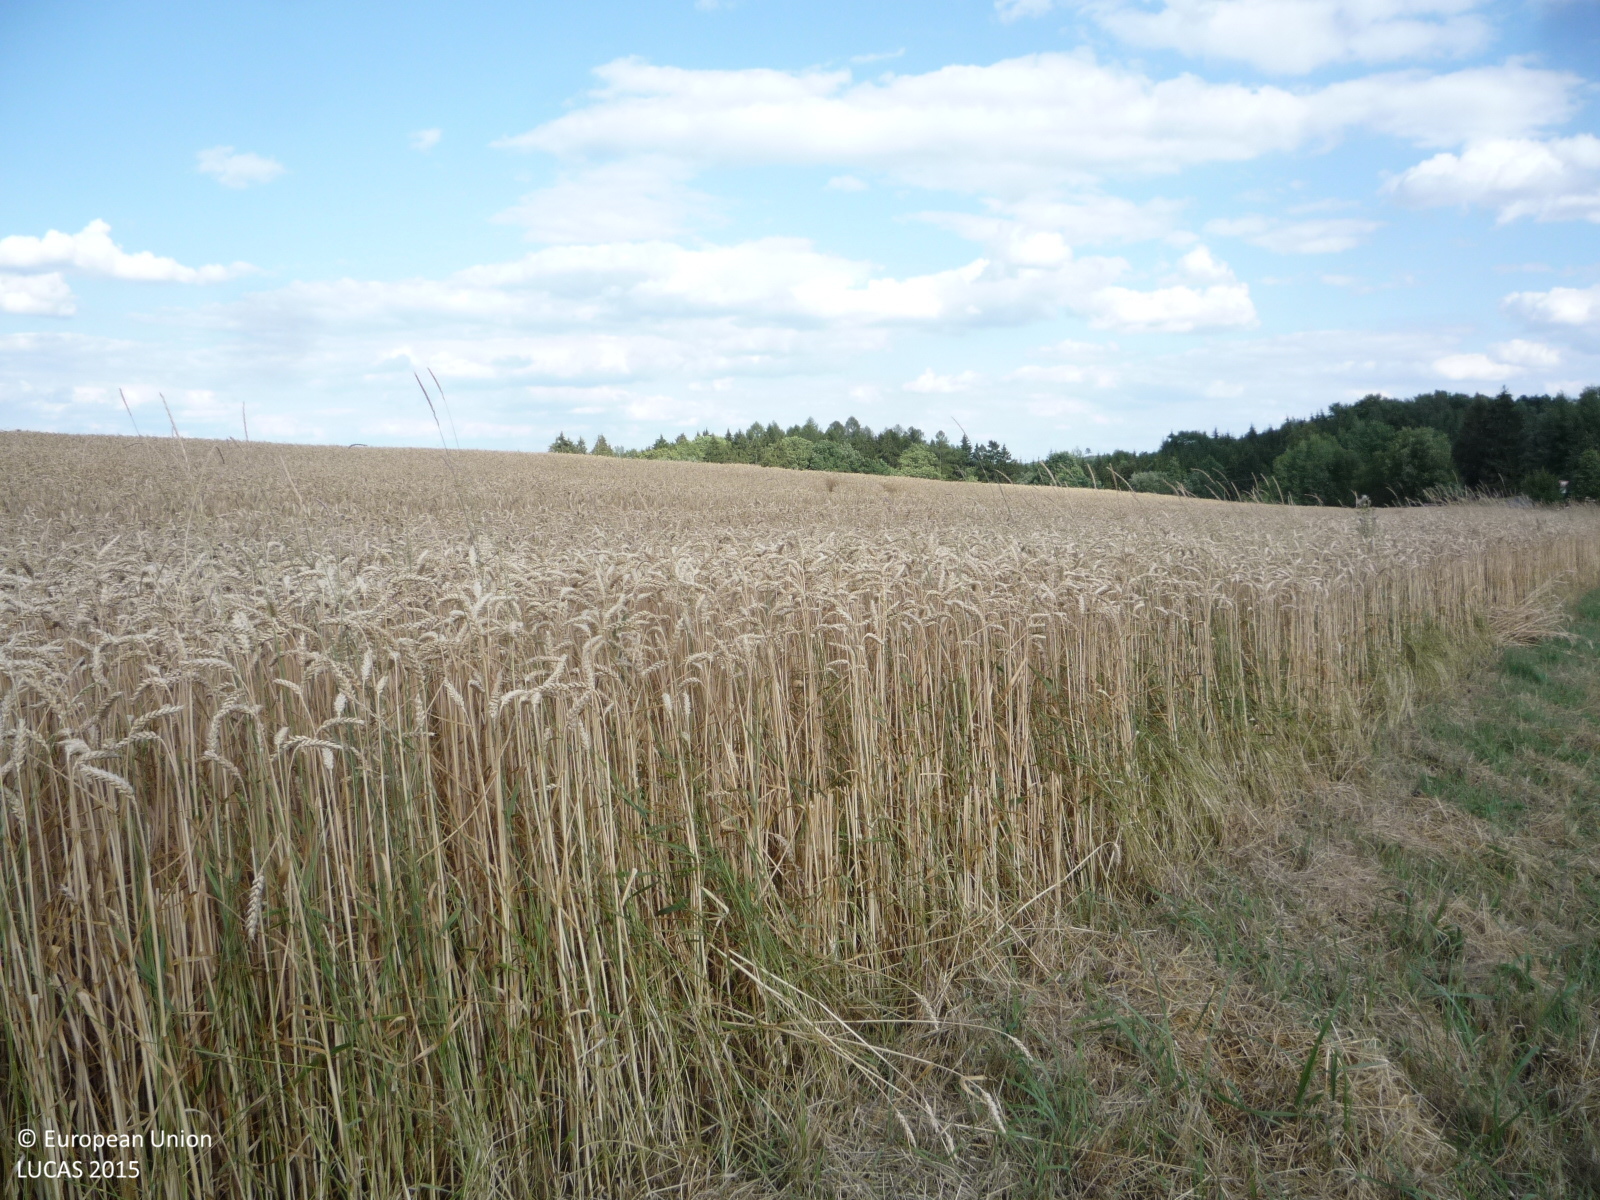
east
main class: Grassland
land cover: Grassland with sparse tree/shrub cover
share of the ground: > 75 %
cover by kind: herbaceous plants 95 %, broadleaved forest trees 5 %
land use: Agriculture (excluding fallow land and kitchen gardens)
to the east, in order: Grassland with sparse tree/shrub cover; Common wheat
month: July
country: CZ
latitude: 50.4761
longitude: 15.2878
